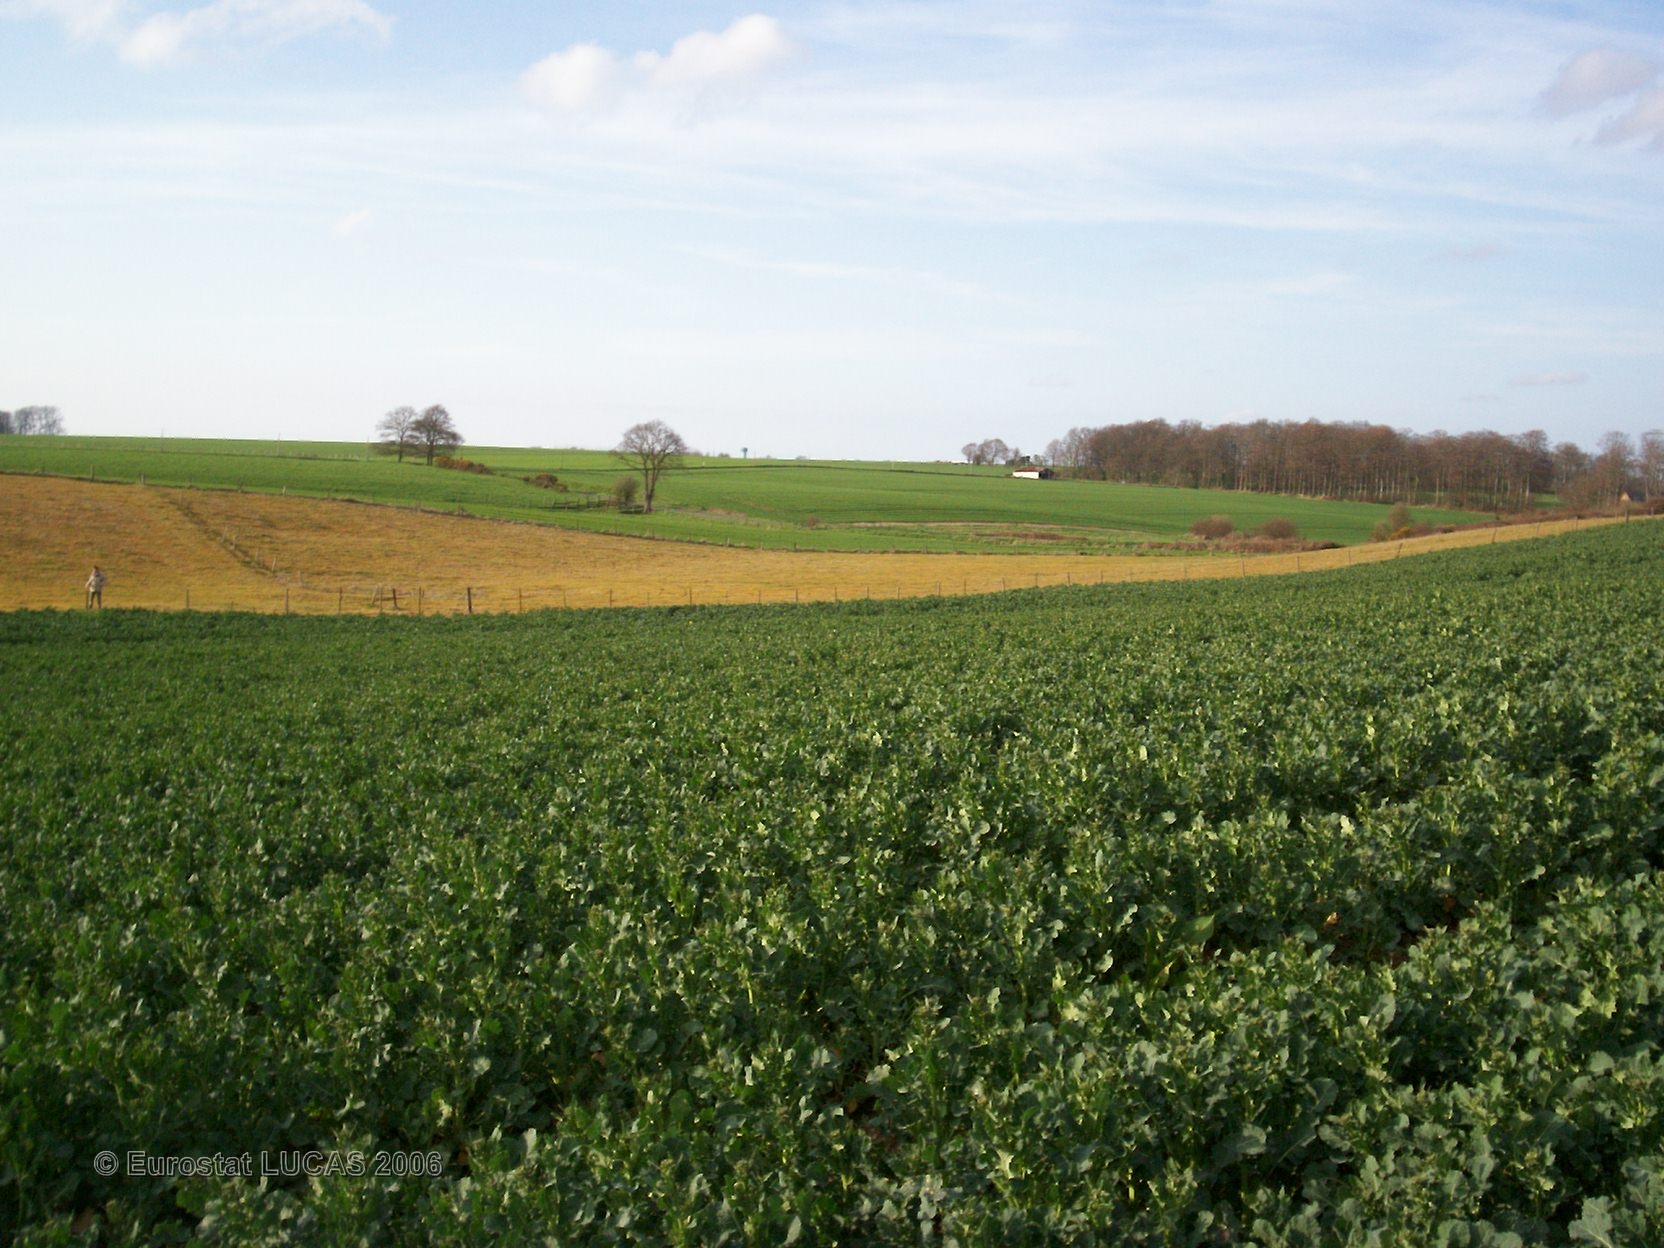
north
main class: Cropland
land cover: Rape and turnip rape
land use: Agriculture (excluding fallow land and kitchen gardens)
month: April
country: FR
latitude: 49.6949
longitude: 0.9241
